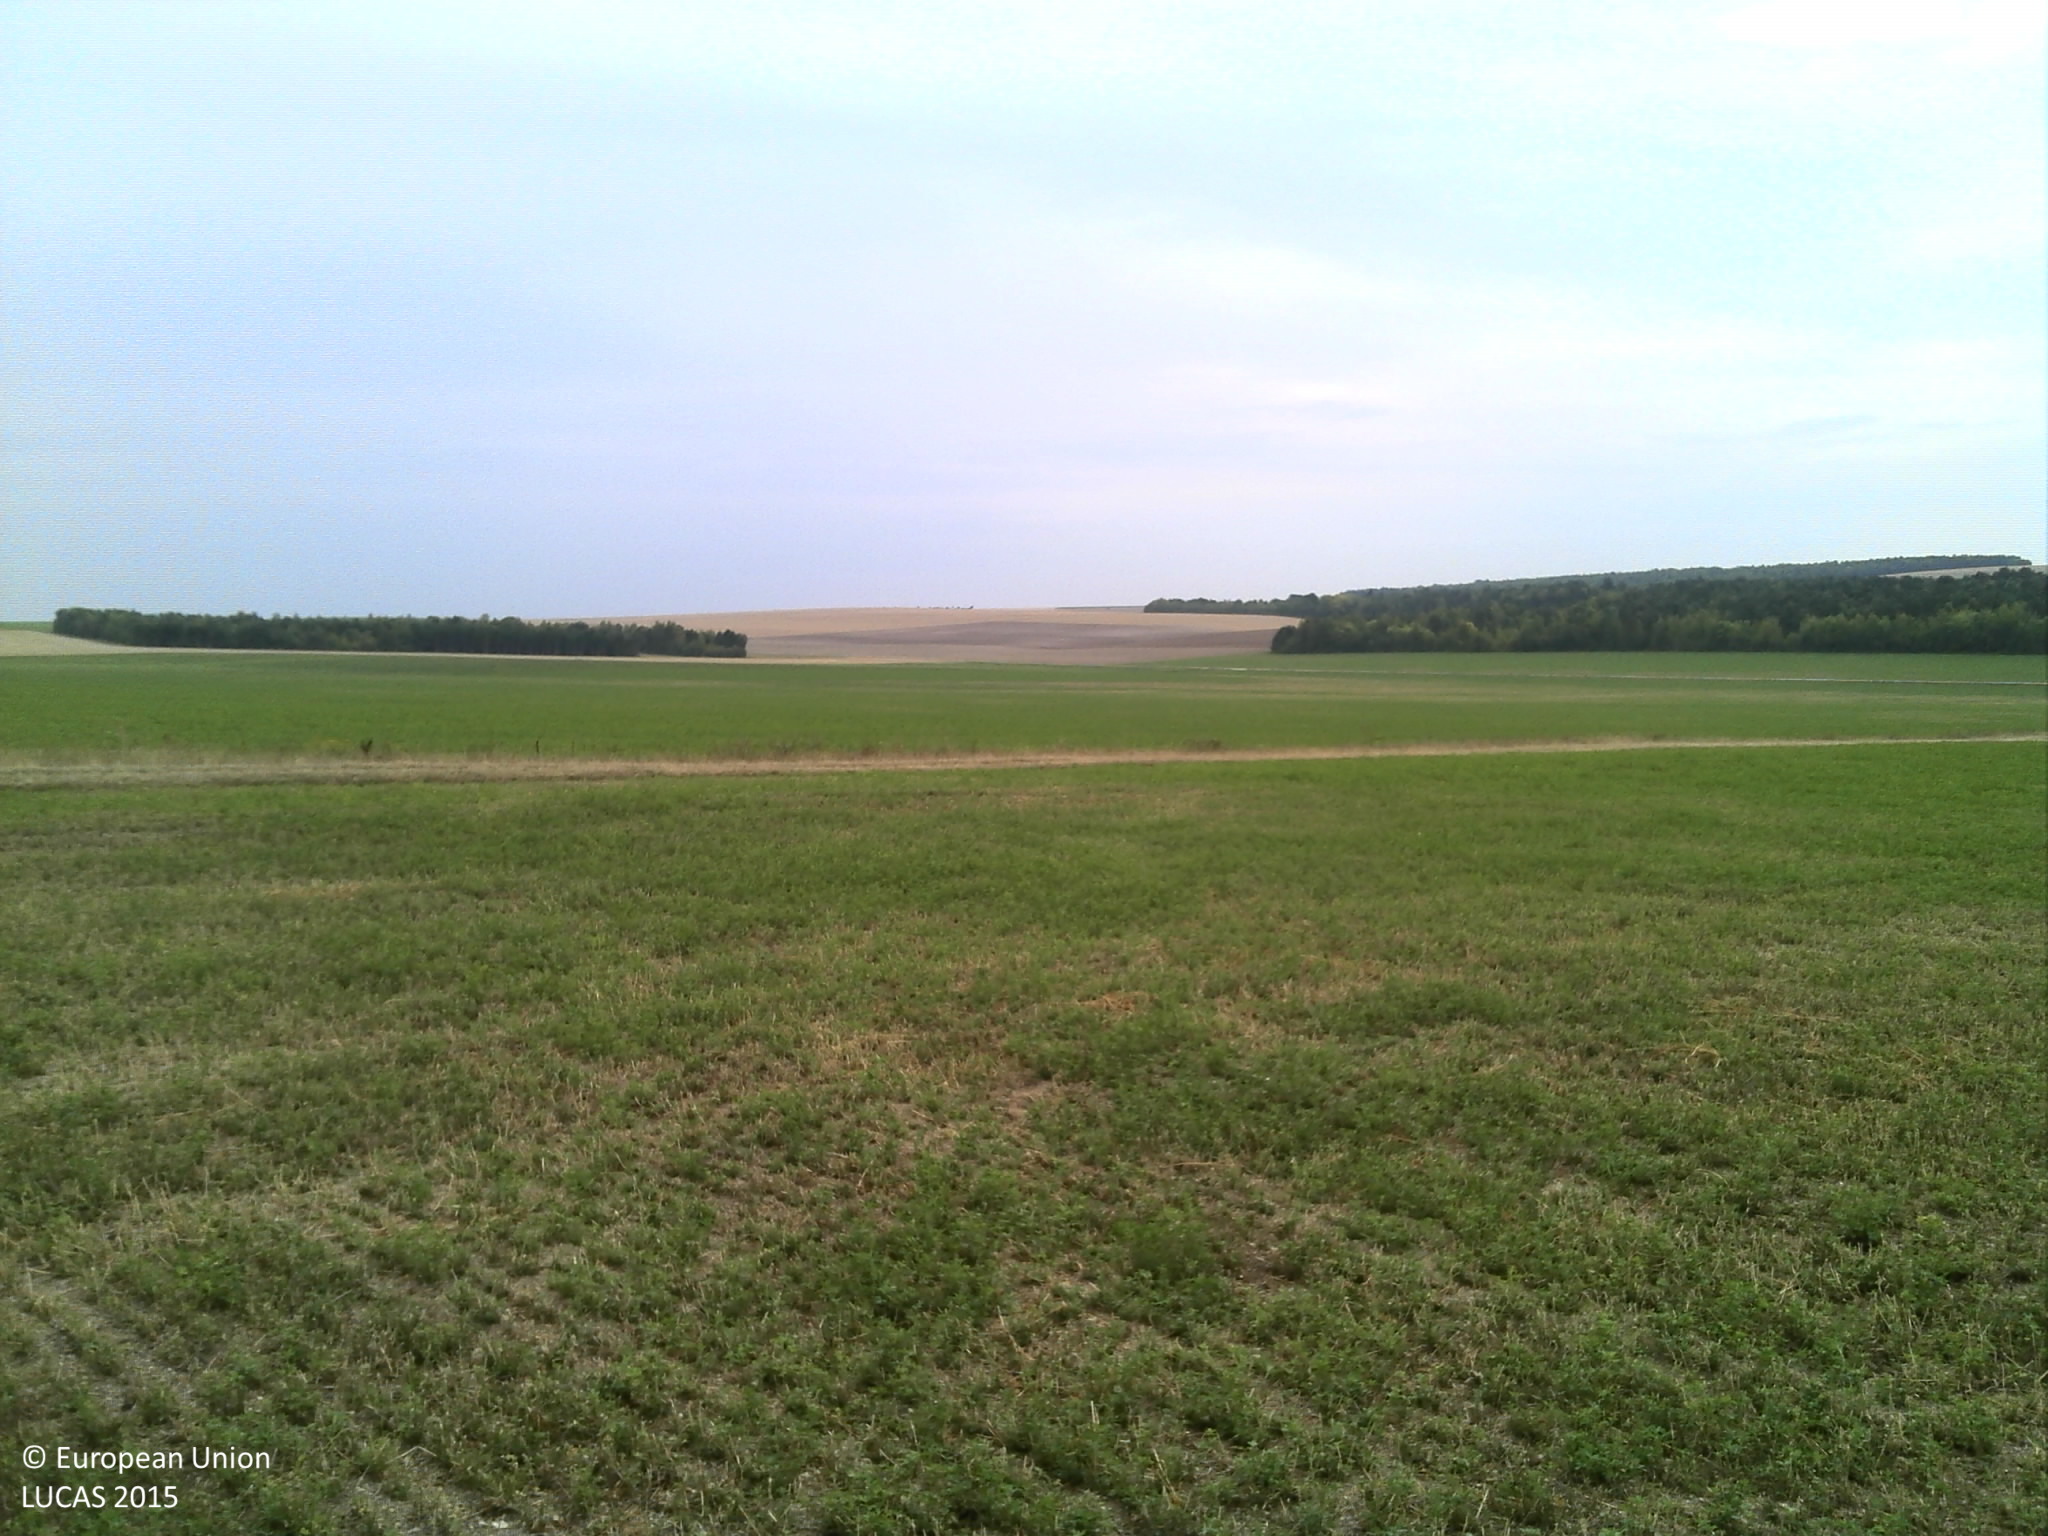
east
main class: Cropland
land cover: Lucerne
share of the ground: > 75 %
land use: Agriculture (excluding fallow land and kitchen gardens)
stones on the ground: 10 - 25 %
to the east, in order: Lucerne; Grass margins; Tracks; Grass margins; Lucerne
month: August
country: FR
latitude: 48.4316
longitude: 4.1983
